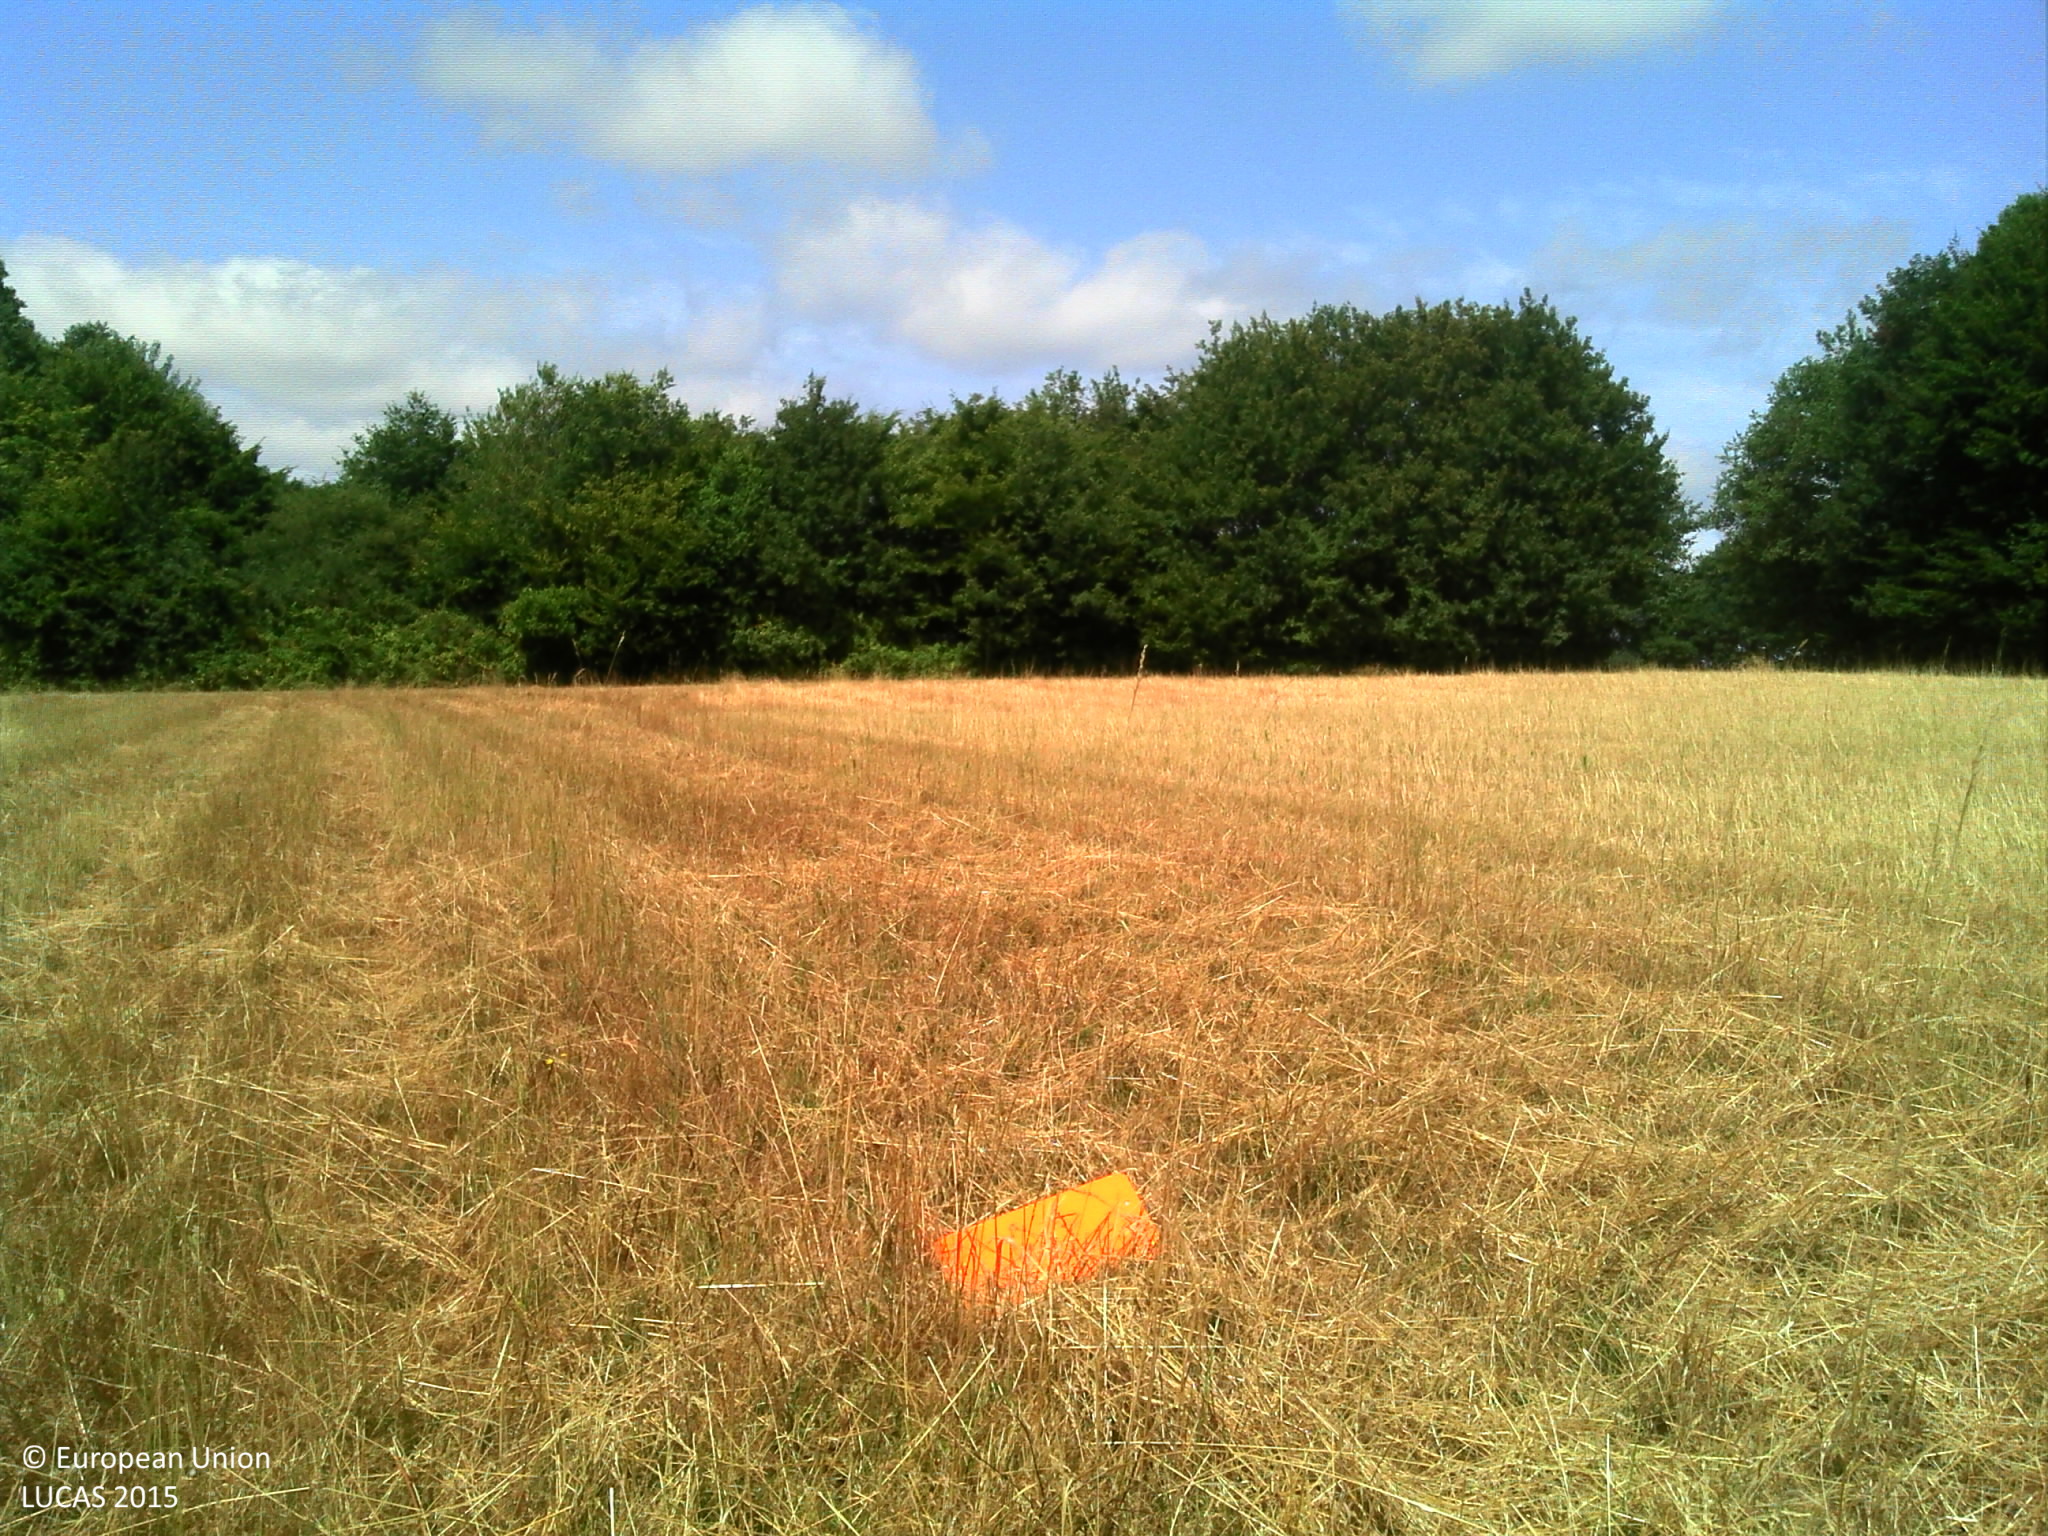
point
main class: Grassland
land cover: Grassland without tree/shrub cover
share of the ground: > 75 %
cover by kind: herbaceous plants 100 %
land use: Agriculture (excluding fallow land and kitchen gardens)
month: July
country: FR
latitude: 47.1822
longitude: 0.5450
